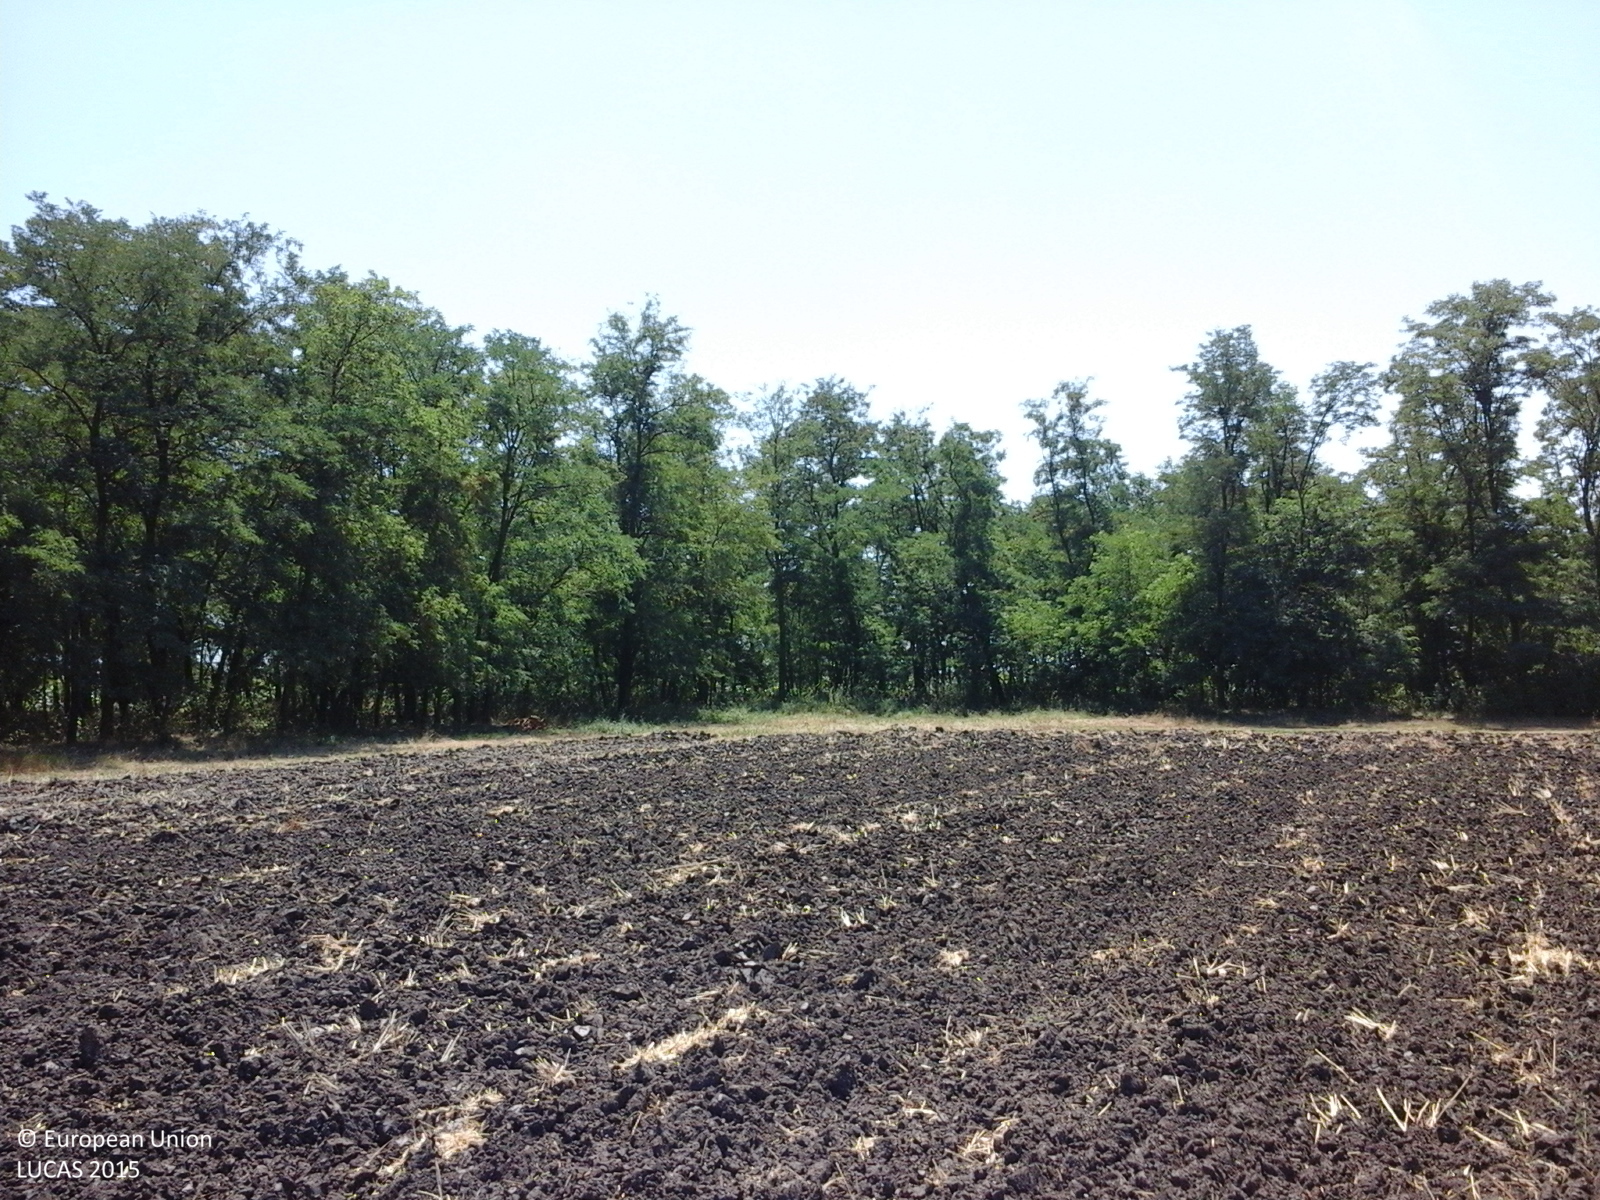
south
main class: Cropland
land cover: Common wheat
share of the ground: < 10 %
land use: Agriculture (excluding fallow land and kitchen gardens)
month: July
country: RO
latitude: 44.2817
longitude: 26.6446
